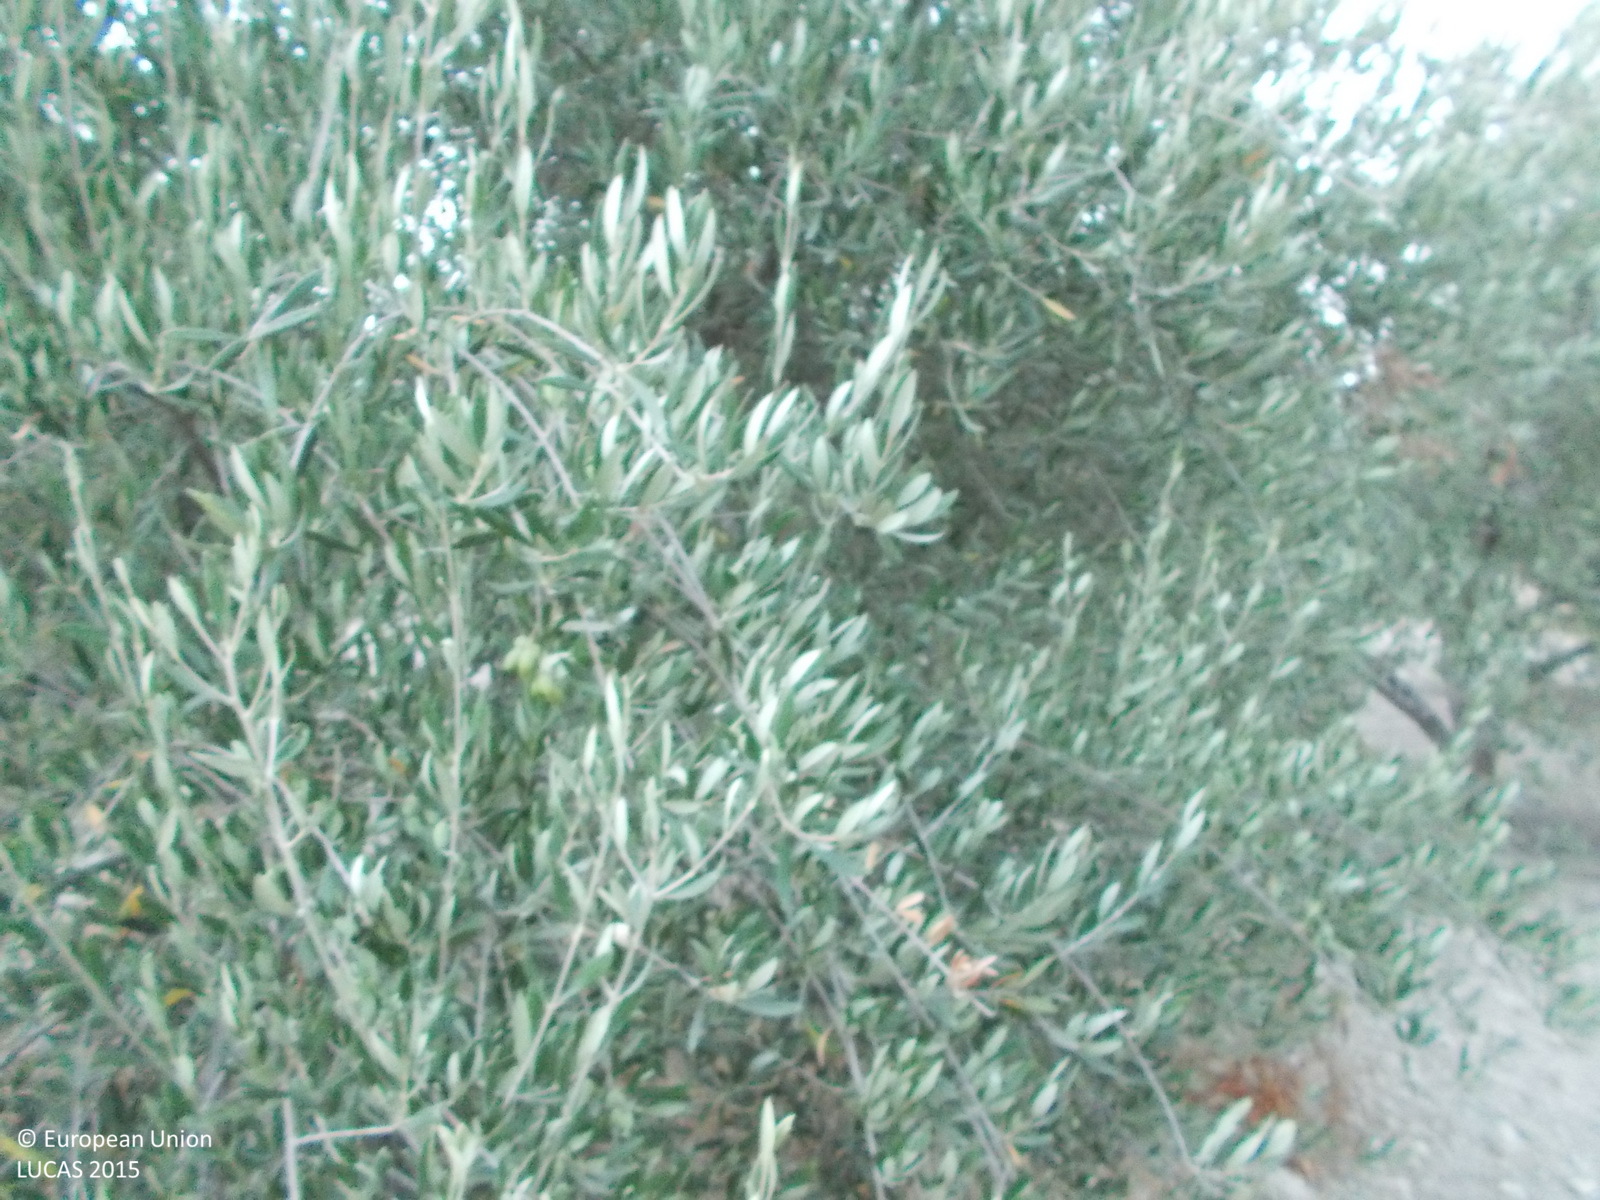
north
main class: Cropland
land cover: Olive groves
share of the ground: > 75 %
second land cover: Other bare soil
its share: > 75 %
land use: Agriculture (excluding fallow land and kitchen gardens)
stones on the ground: < 10 %
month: May
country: CY
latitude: 34.7879
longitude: 33.3150
